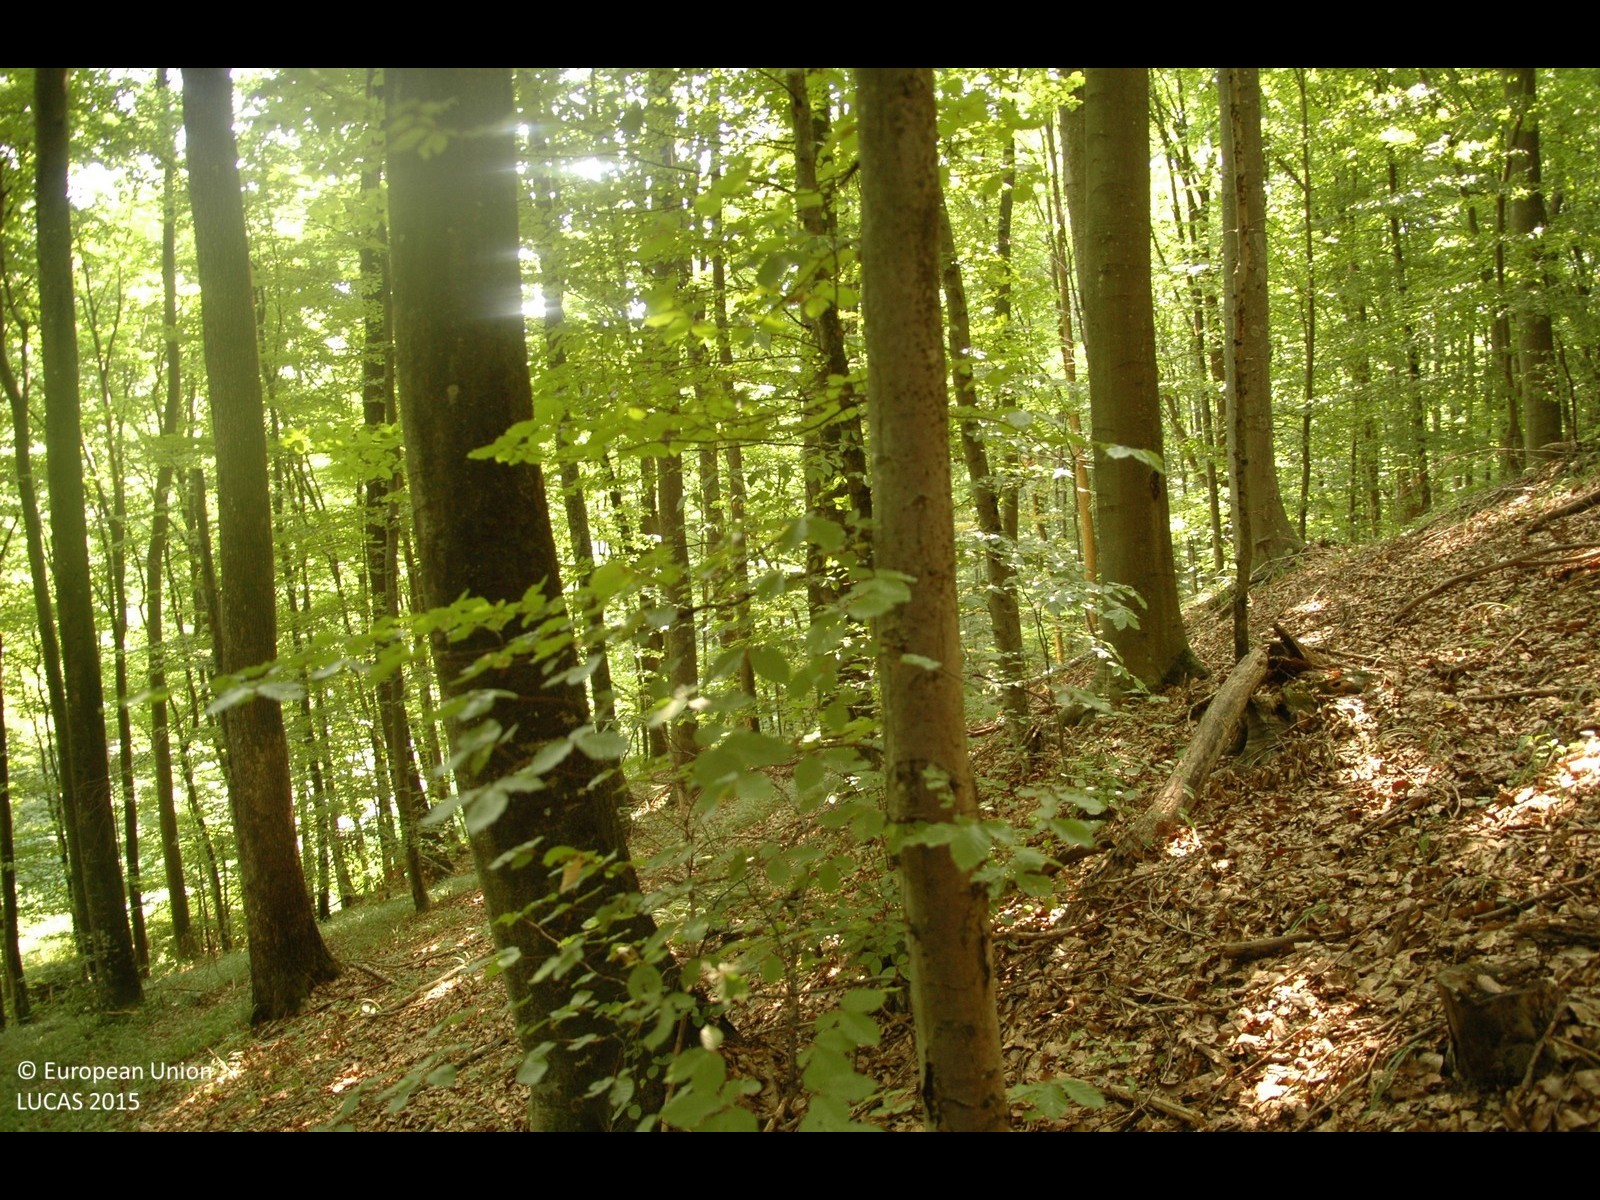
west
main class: Woodland
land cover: Broadleaved woodland
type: beech forest
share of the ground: > 75 %
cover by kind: broadleaved forest trees 100 %
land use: Forestry
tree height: > 5 m
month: July
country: HR
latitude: 46.1511
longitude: 16.5389
